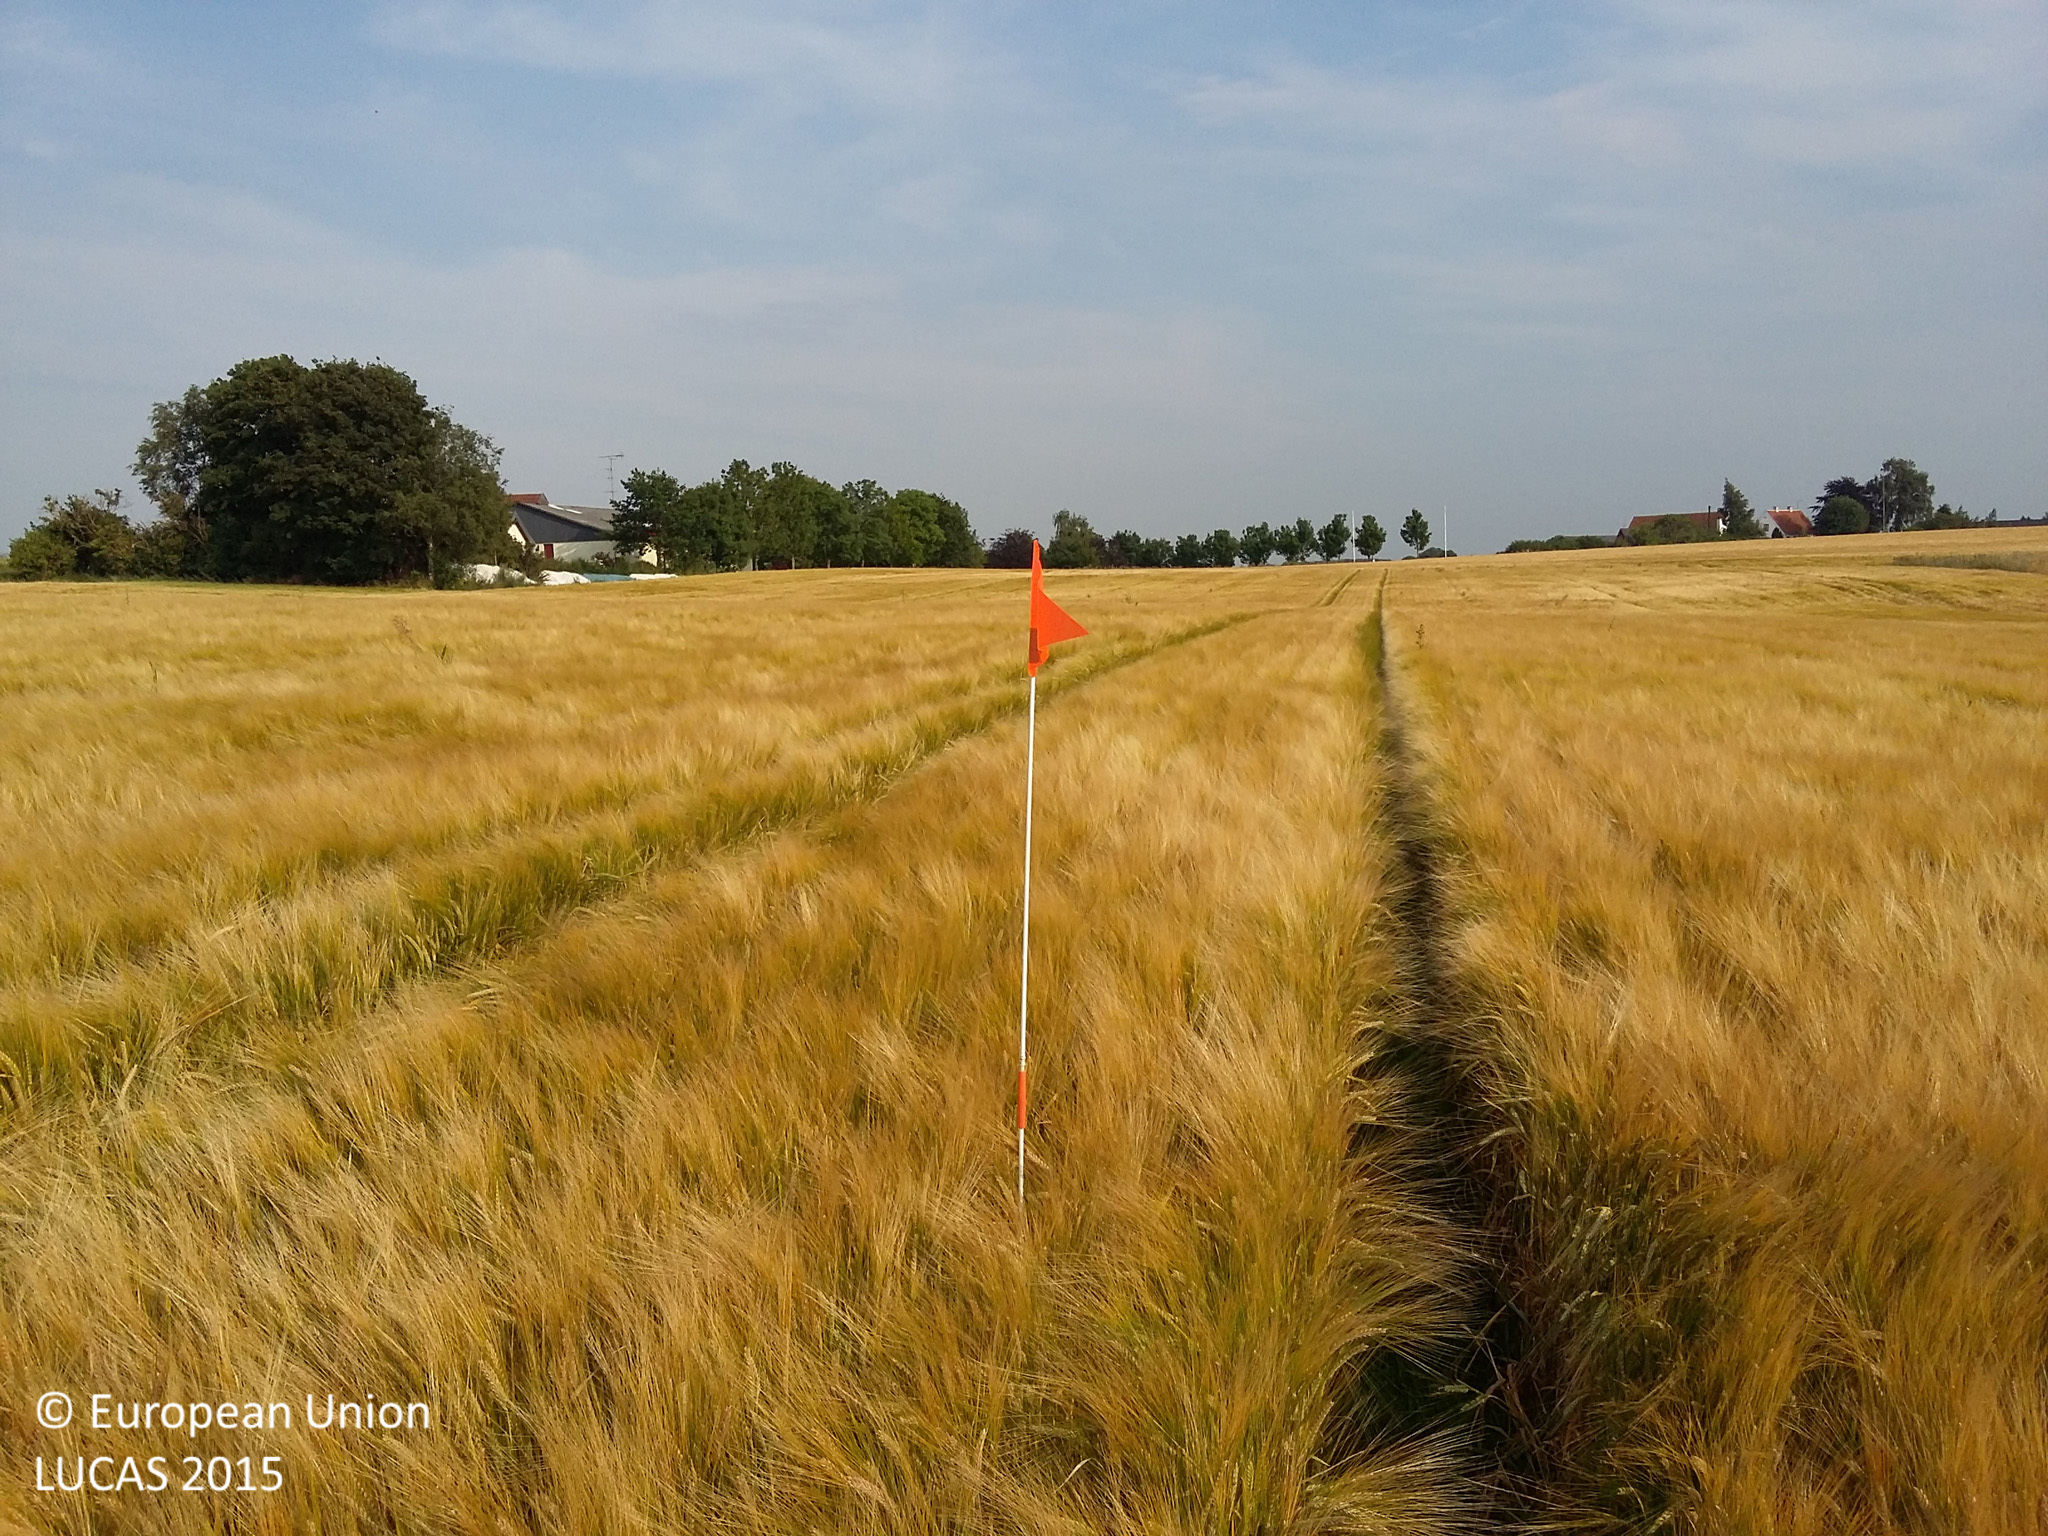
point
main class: Cropland
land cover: Barley
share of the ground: > 75 %
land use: Agriculture (excluding fallow land and kitchen gardens)
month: August
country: DK
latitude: 55.5092
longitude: 11.8511
